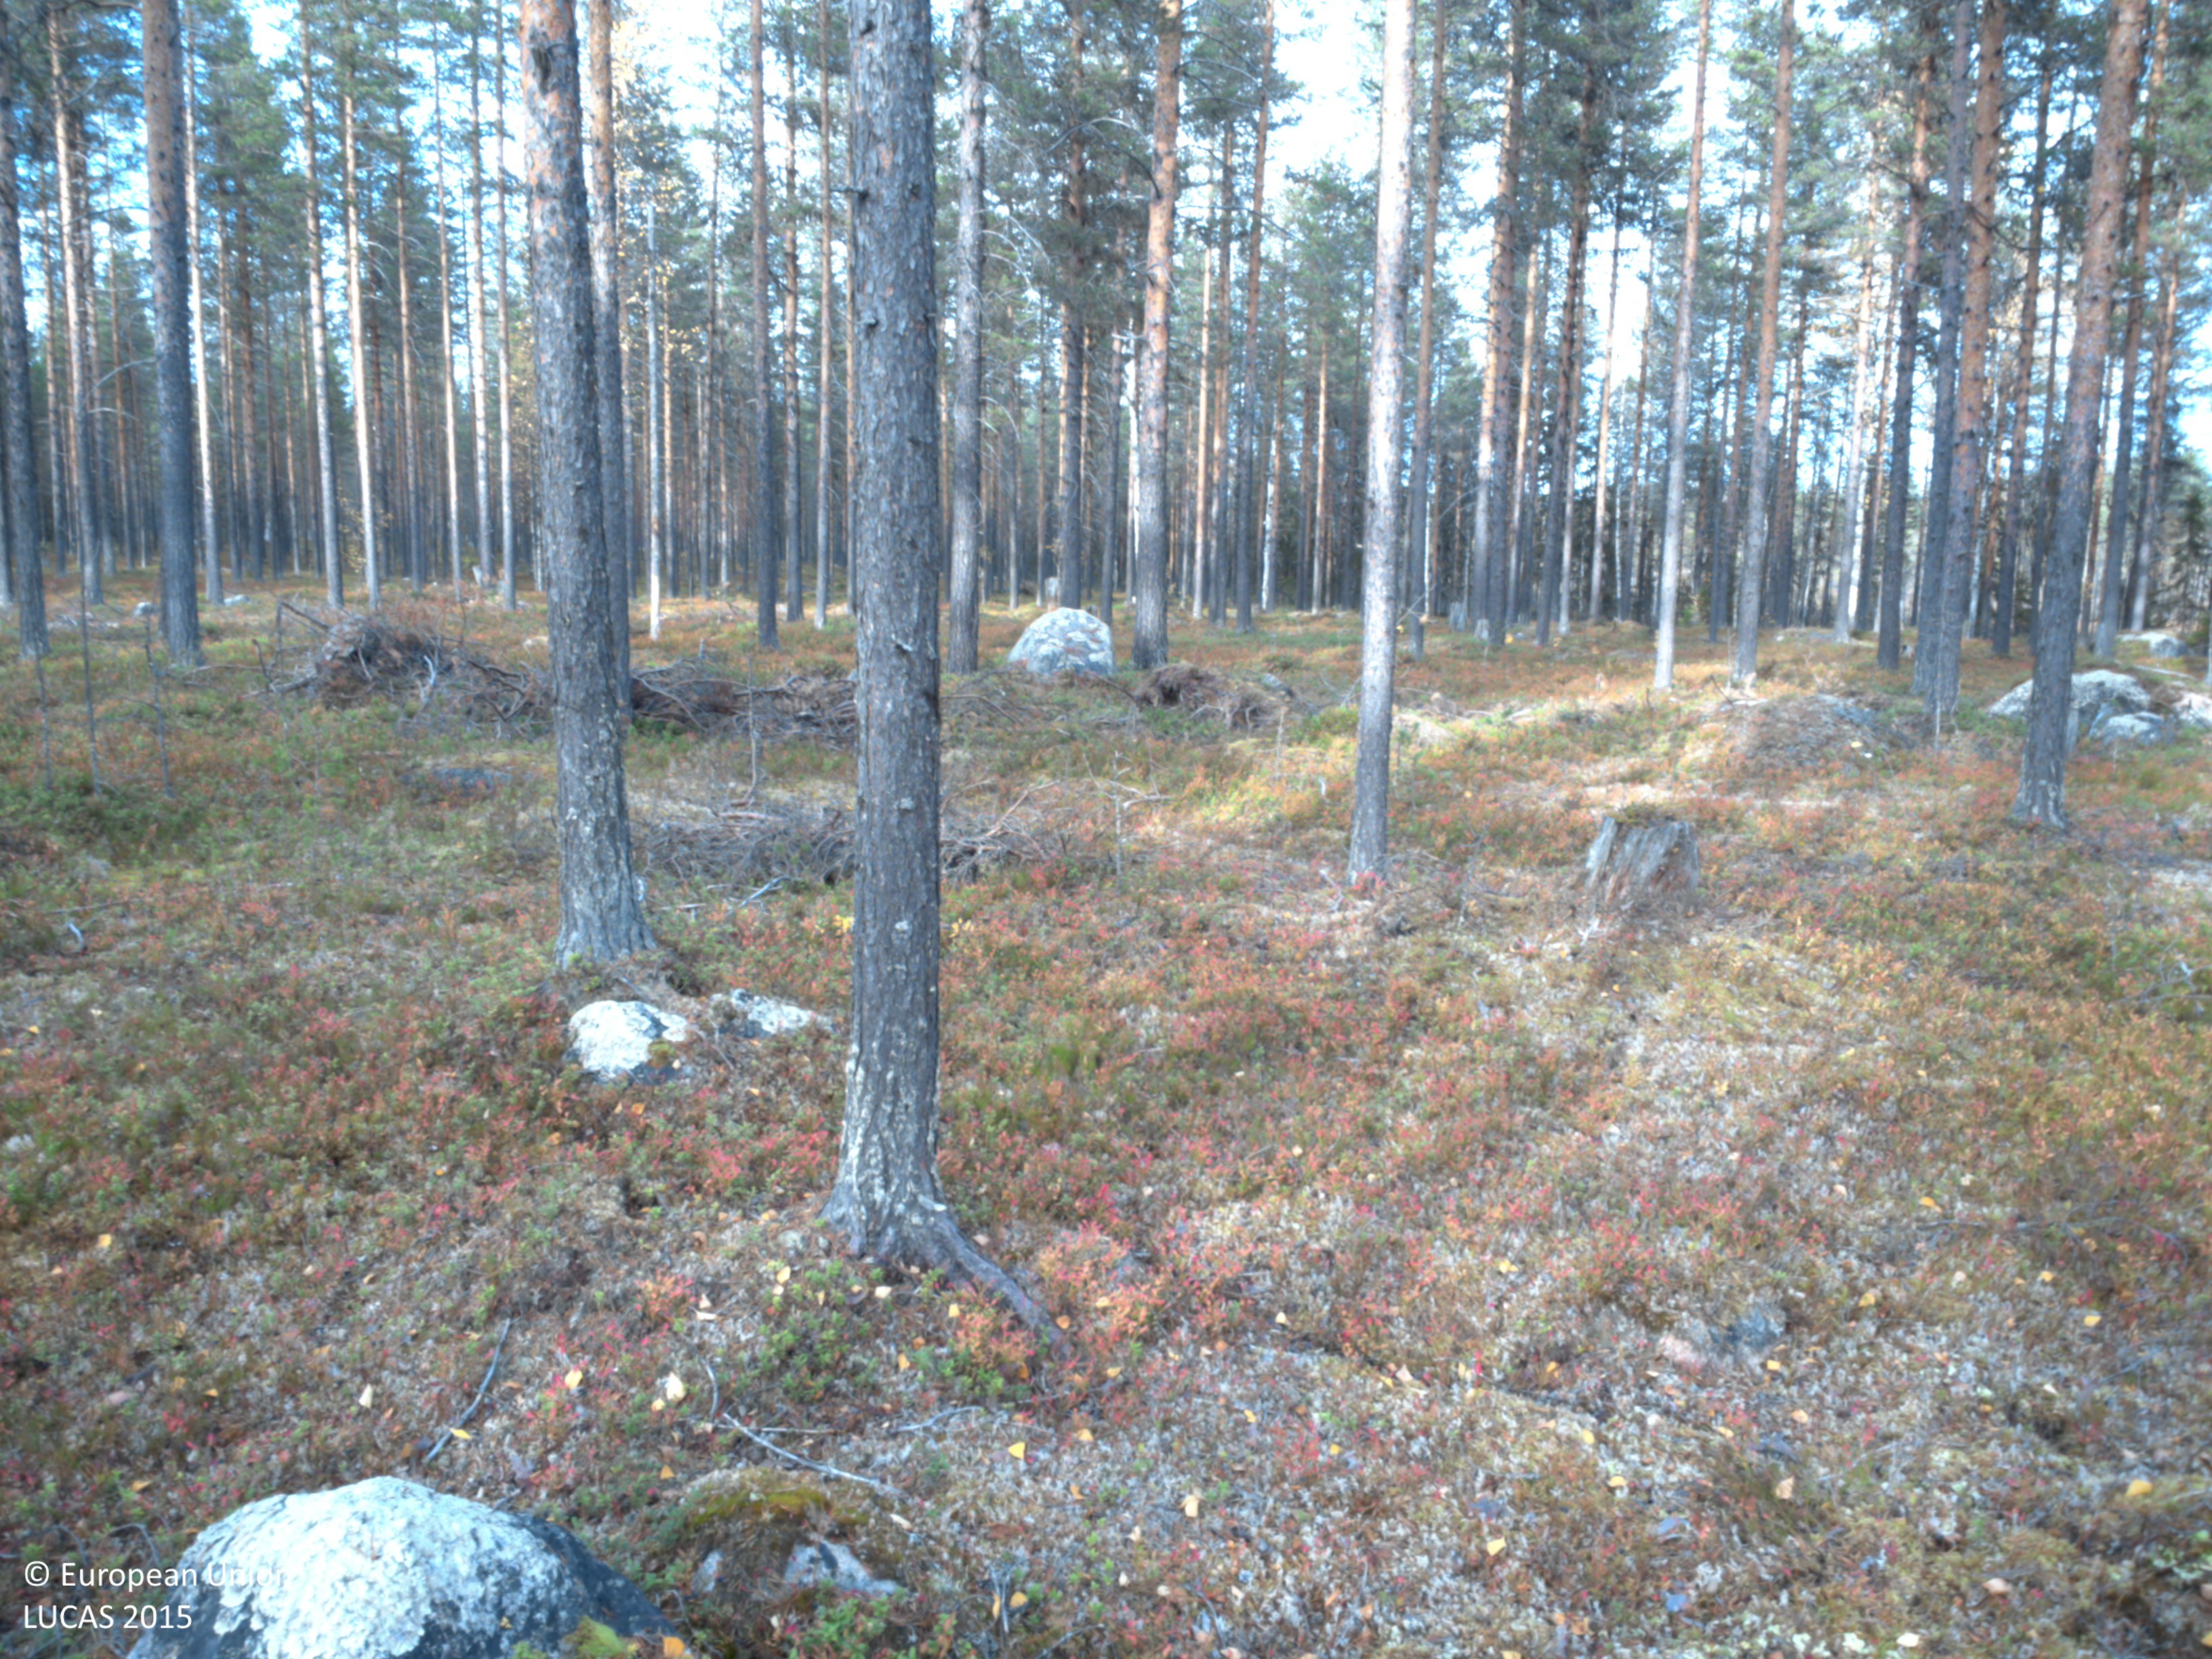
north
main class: Woodland
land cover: Pine dominated coniferous woodland
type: boreal forest
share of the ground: > 75 %
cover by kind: coniferous forest trees 55 %, shrubs 30 %, lichens and mosses 5 %, consolidated bare surface 5 %
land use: Forestry
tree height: > 5 m
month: September
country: SE
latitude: 64.8964
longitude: 18.5207
